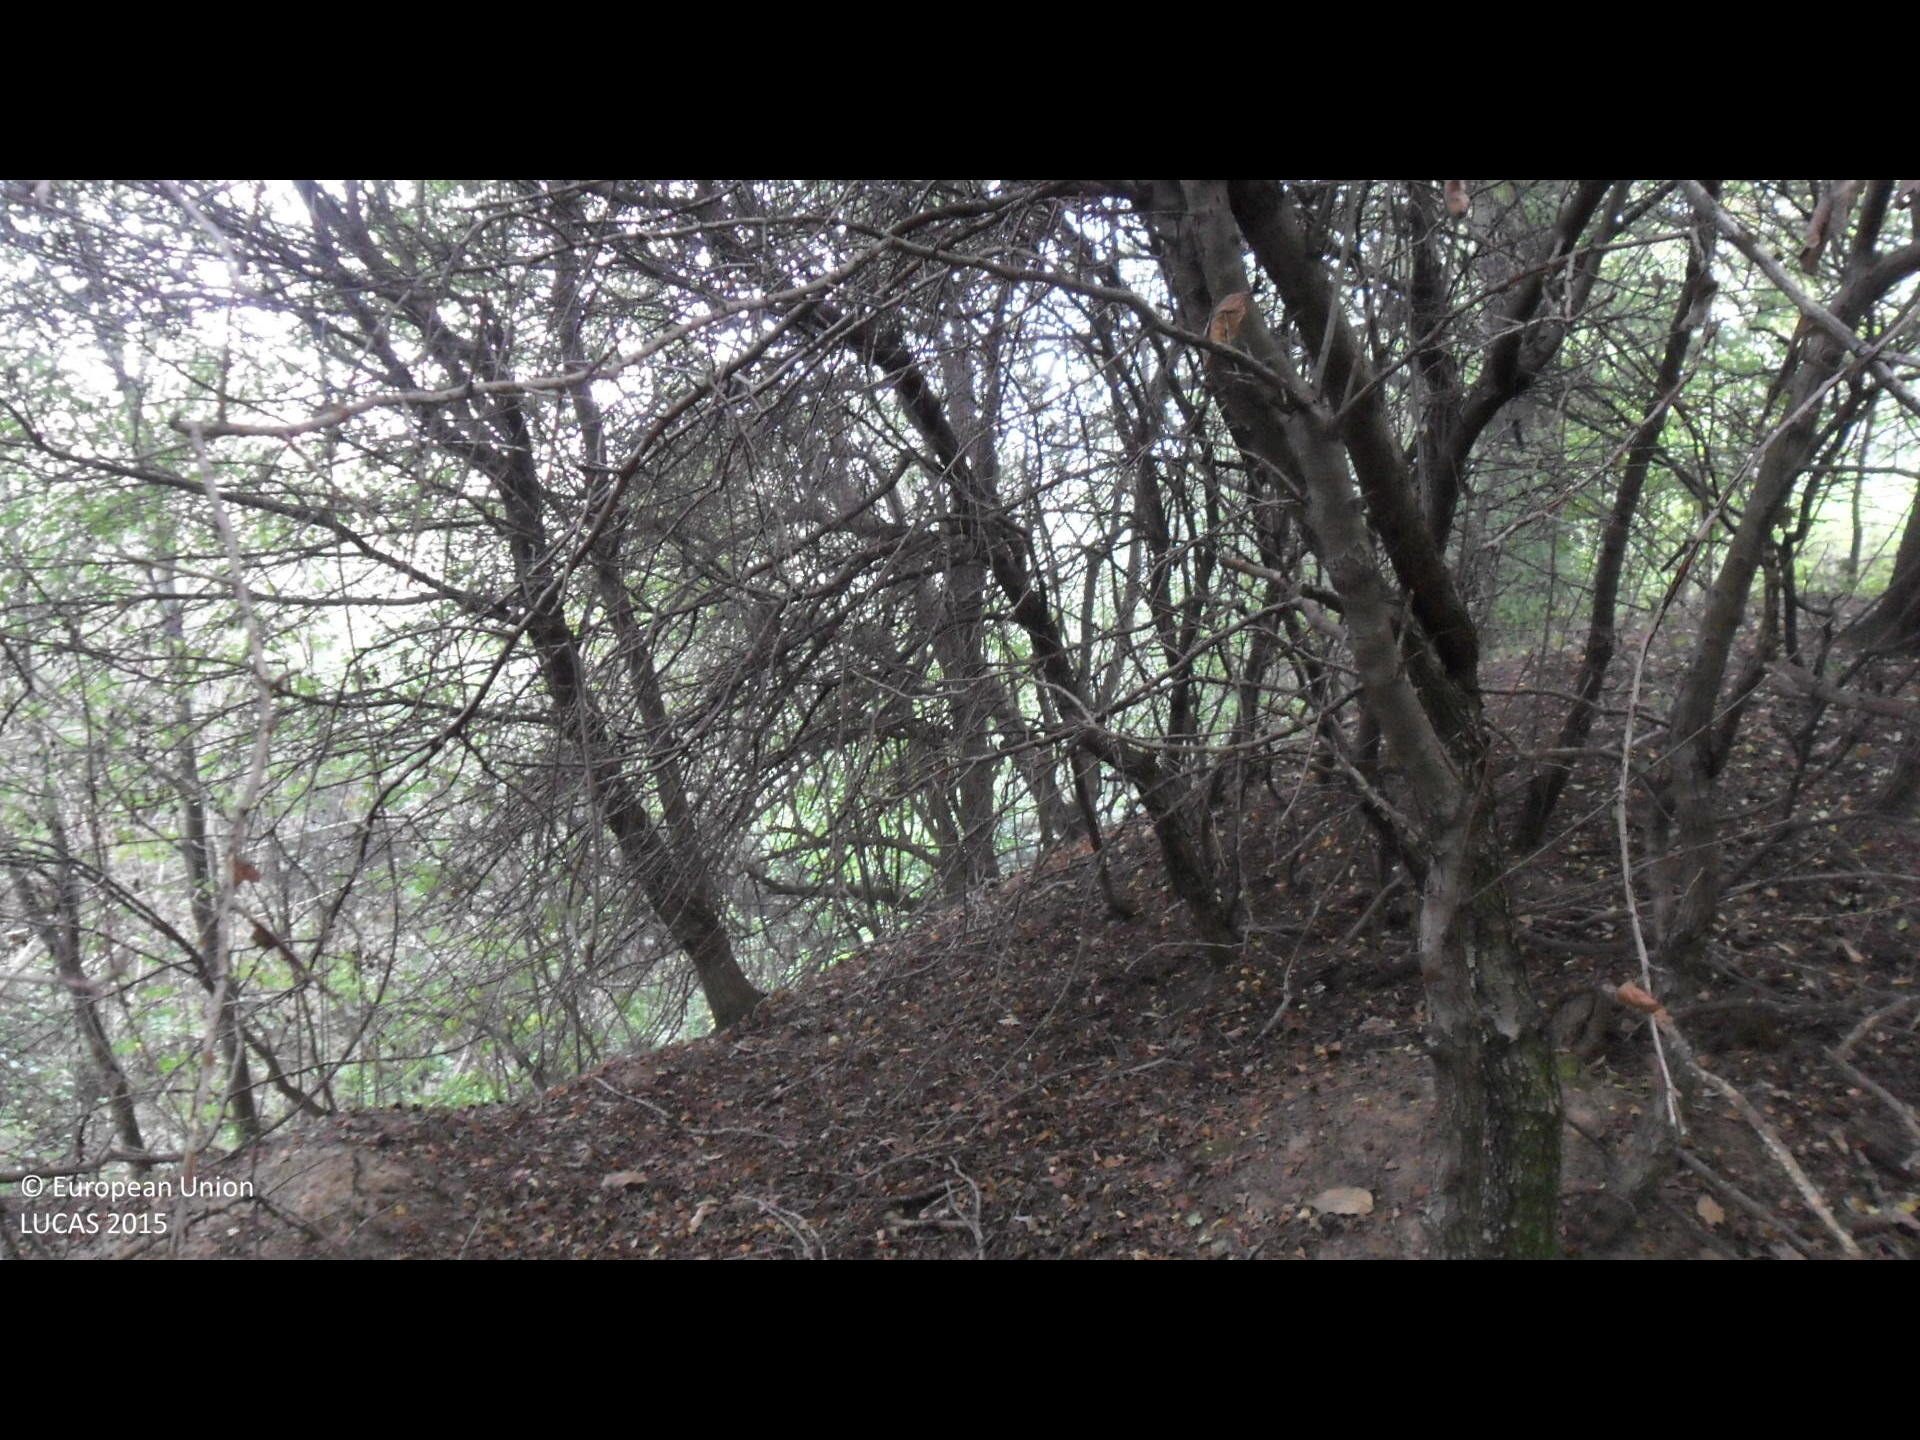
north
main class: Woodland
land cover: Broadleaved woodland
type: mesophytic deciduous forest
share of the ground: > 75 %
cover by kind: broadleaved forest trees 95 %, unconsolidated bare surface 5 %
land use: Agriculture (excluding fallow land and kitchen gardens)
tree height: > 5 m
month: September
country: BG
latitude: 43.0999
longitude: 26.4522
